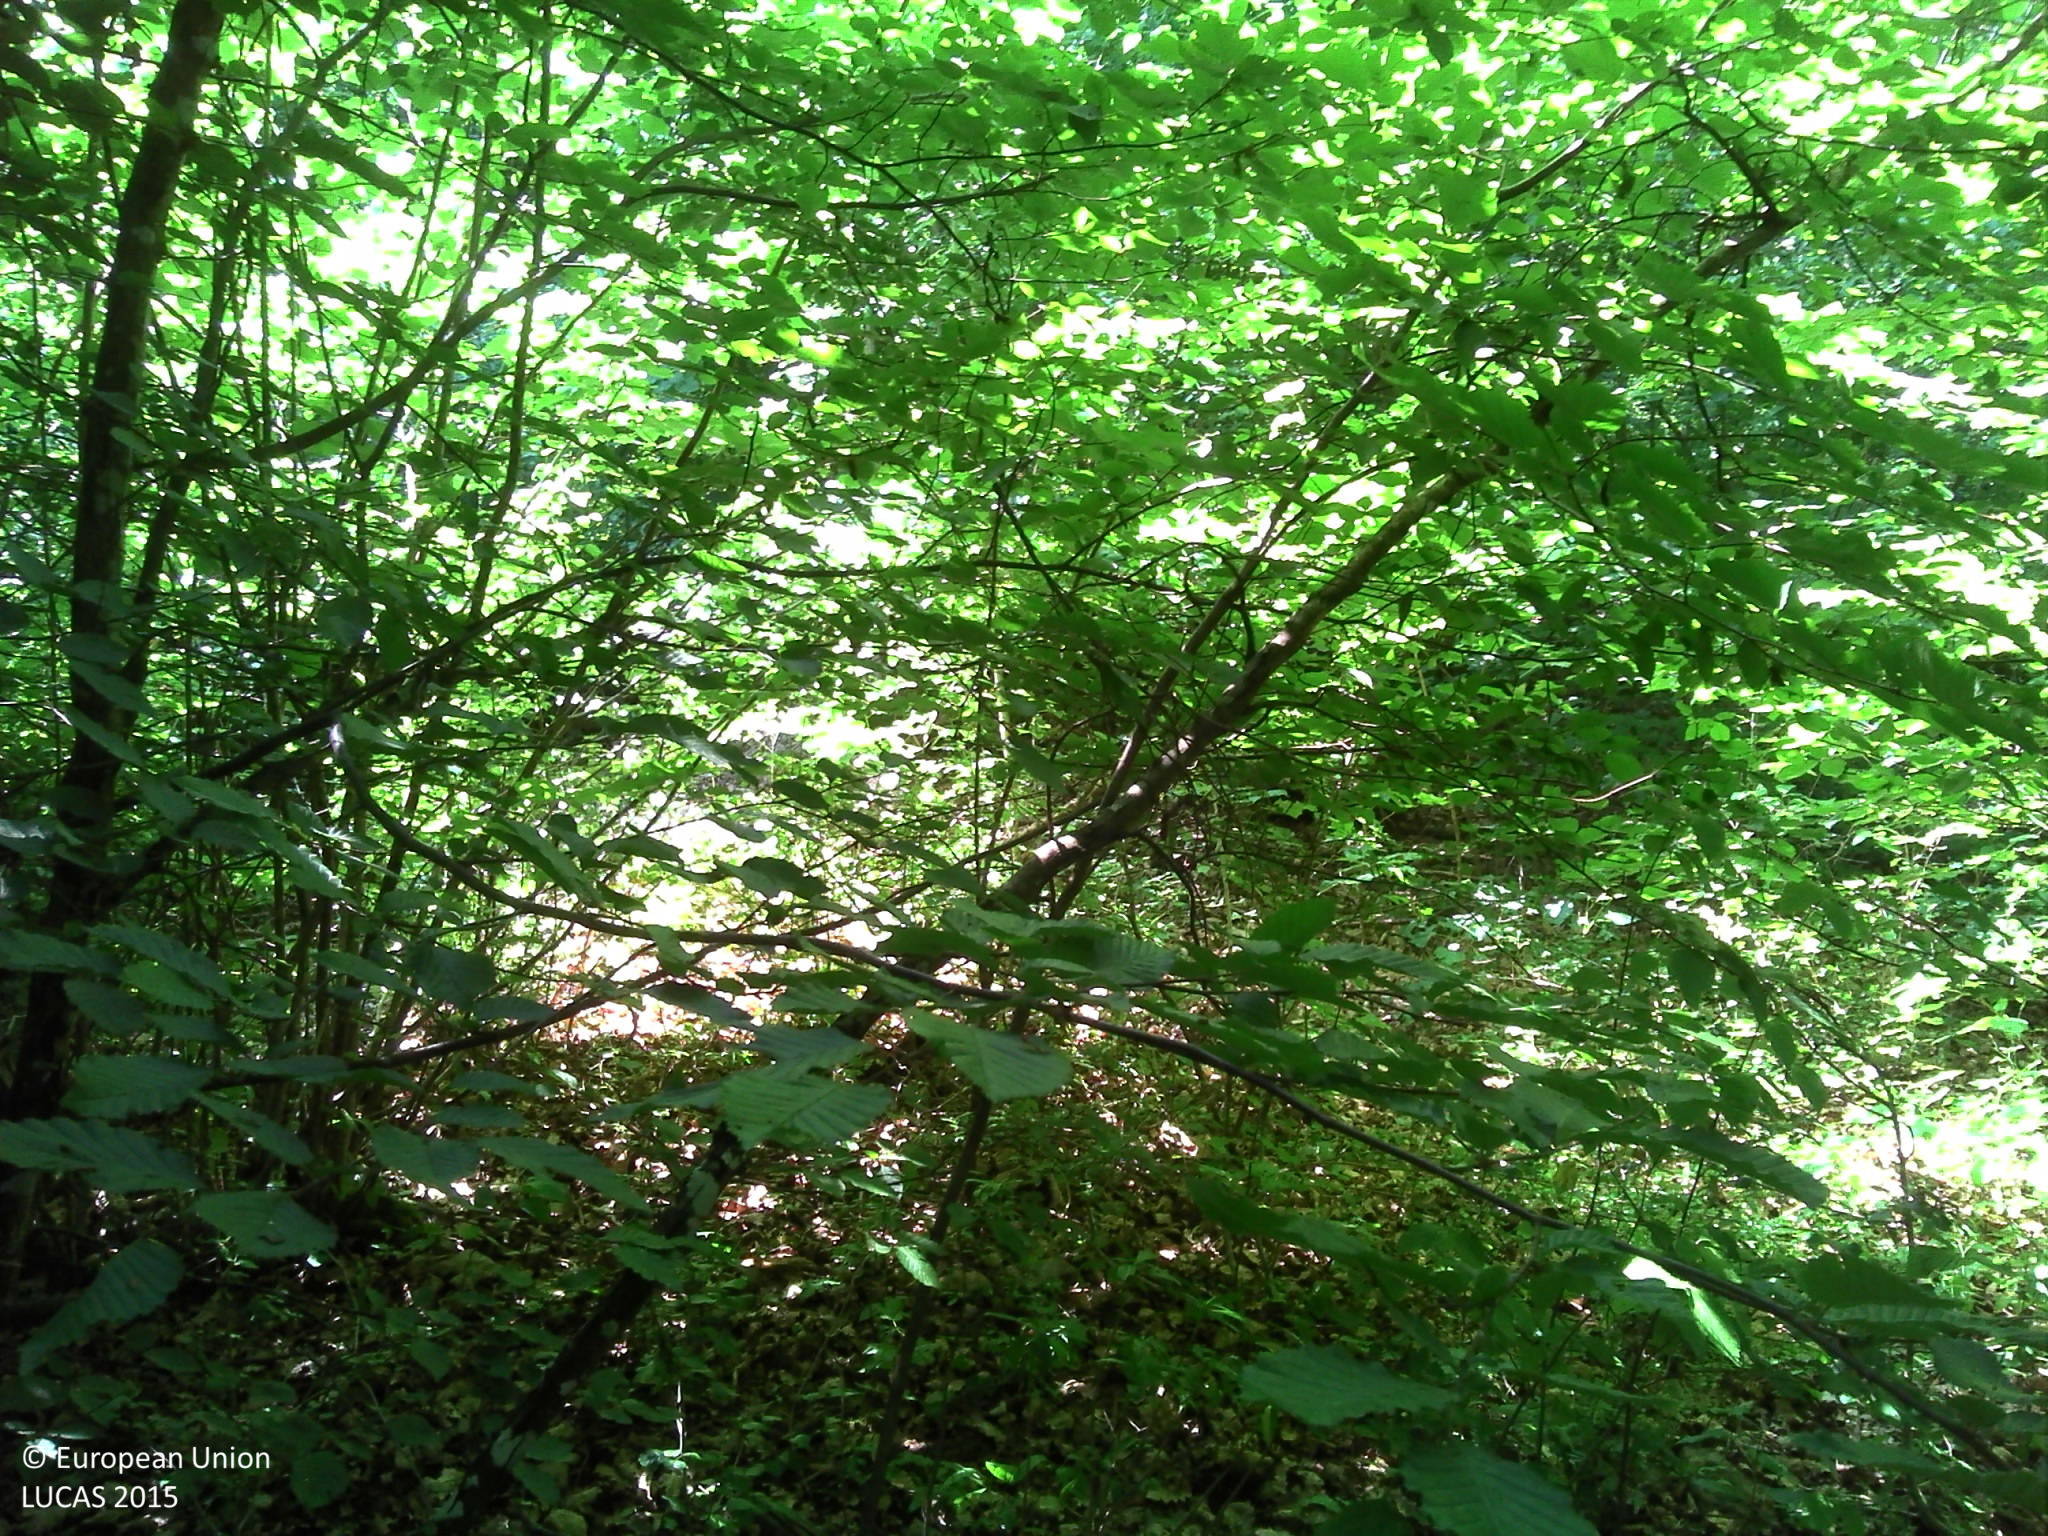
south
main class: Woodland
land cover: Broadleaved woodland
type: mesophytic deciduous forest
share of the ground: > 75 %
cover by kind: broadleaved forest trees 90 %, herbaceous plants 5 %, lichens and mosses 5 %
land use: Forestry
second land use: Amenities, museums, leisure
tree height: > 5 m
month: July
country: FR
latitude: 48.6392
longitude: 6.0508
